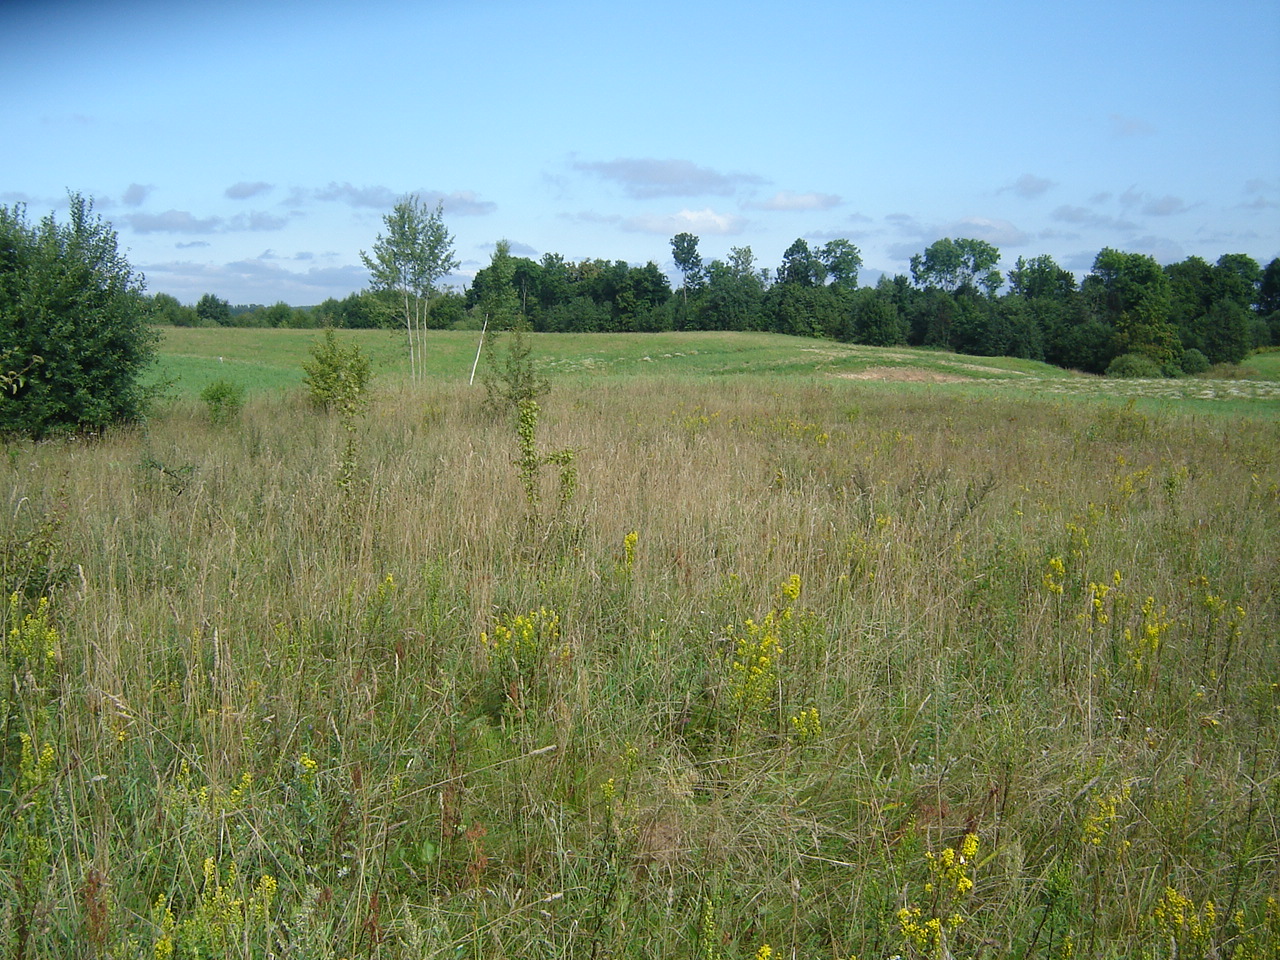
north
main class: Grassland
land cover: Grassland with sparse tree/shrub cover
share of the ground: > 75 %
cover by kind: herbaceous plants 90 %, broadleaved forest trees 5 %, shrubs 5 %
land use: Agriculture (excluding fallow land and kitchen gardens)
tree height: > 5 m
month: August
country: LT
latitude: 54.9274
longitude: 24.8887
